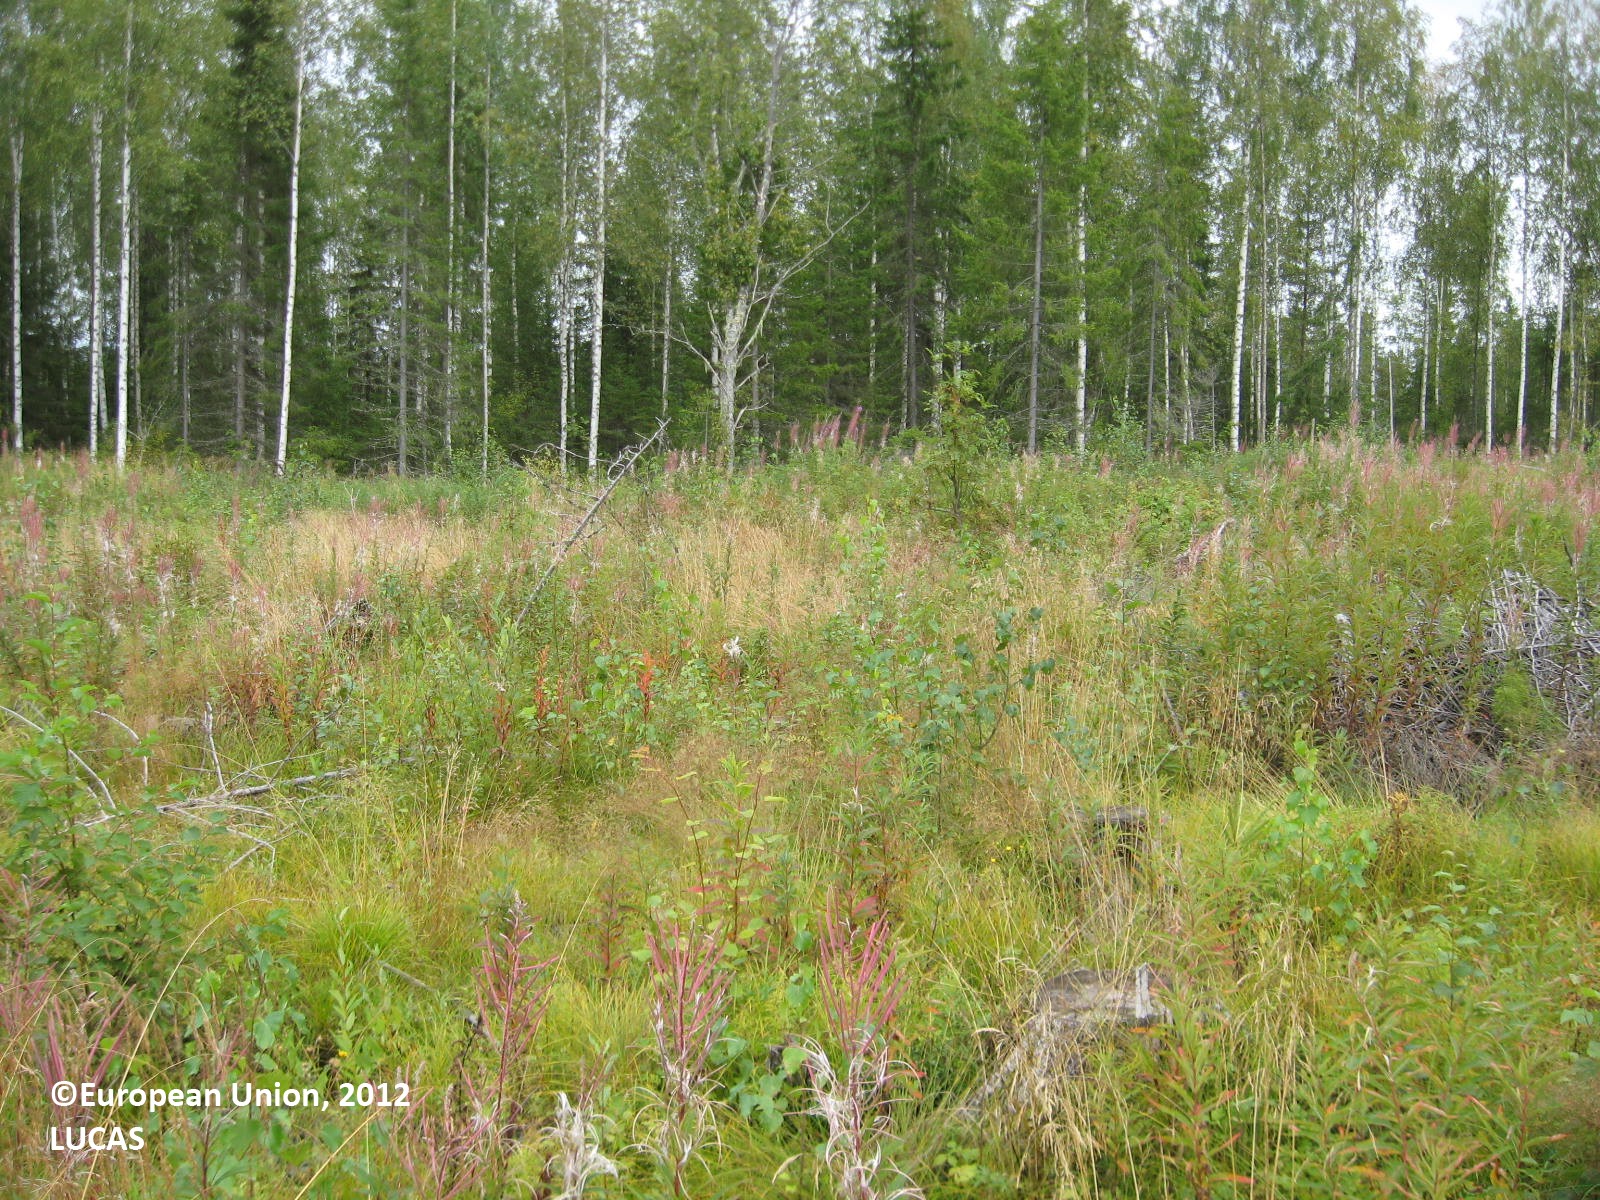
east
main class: Shrubland
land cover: Shrubland without tree cover
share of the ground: 50 - 75 %
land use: Forestry
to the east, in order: Shrubland without tree cover; Ditches and canals; Other mixed woodland; Ditches and canals; Grass margins; Oats; Grass margins; Ditches and canals; Other mixed woodland; Ditches and canals; Grass margins; Oats
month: August
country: FI
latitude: 63.6603
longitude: 29.0132
